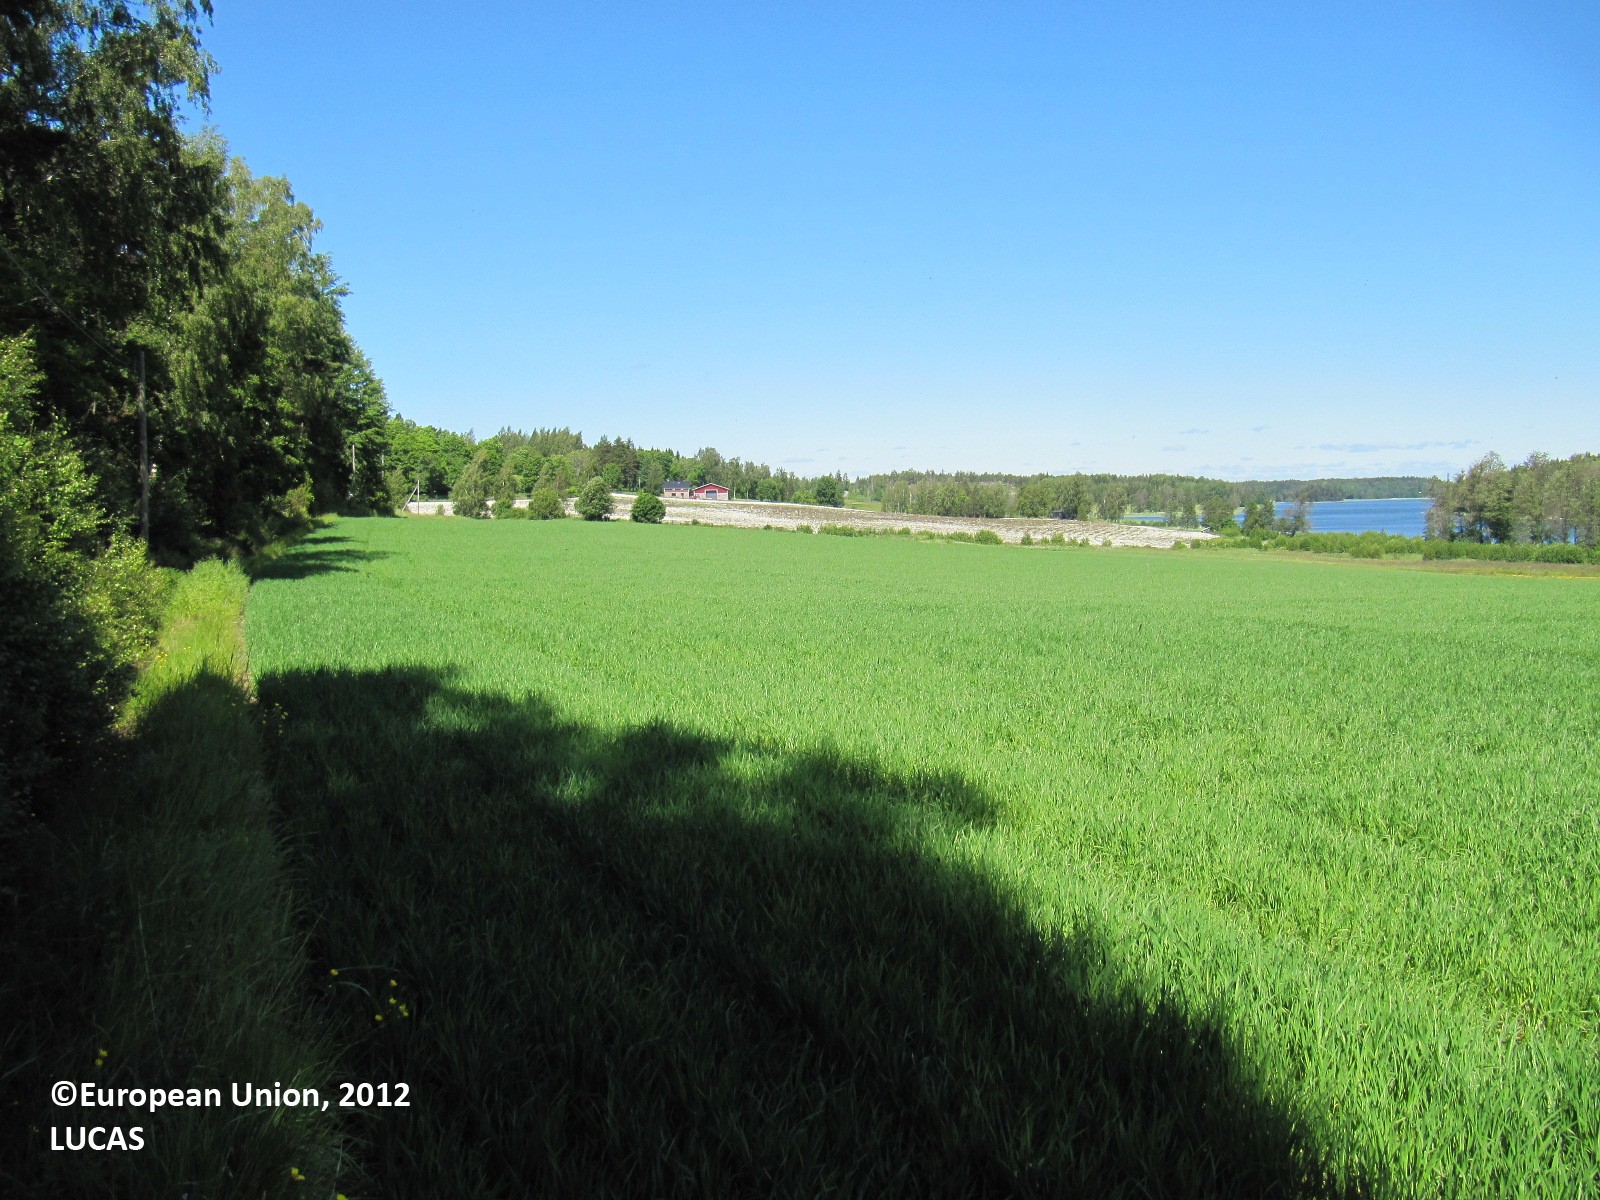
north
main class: Cropland
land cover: Barley
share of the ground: > 75 %
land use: Agriculture (excluding fallow land and kitchen gardens)
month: June
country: FI
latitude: 60.0065
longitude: 23.0846
